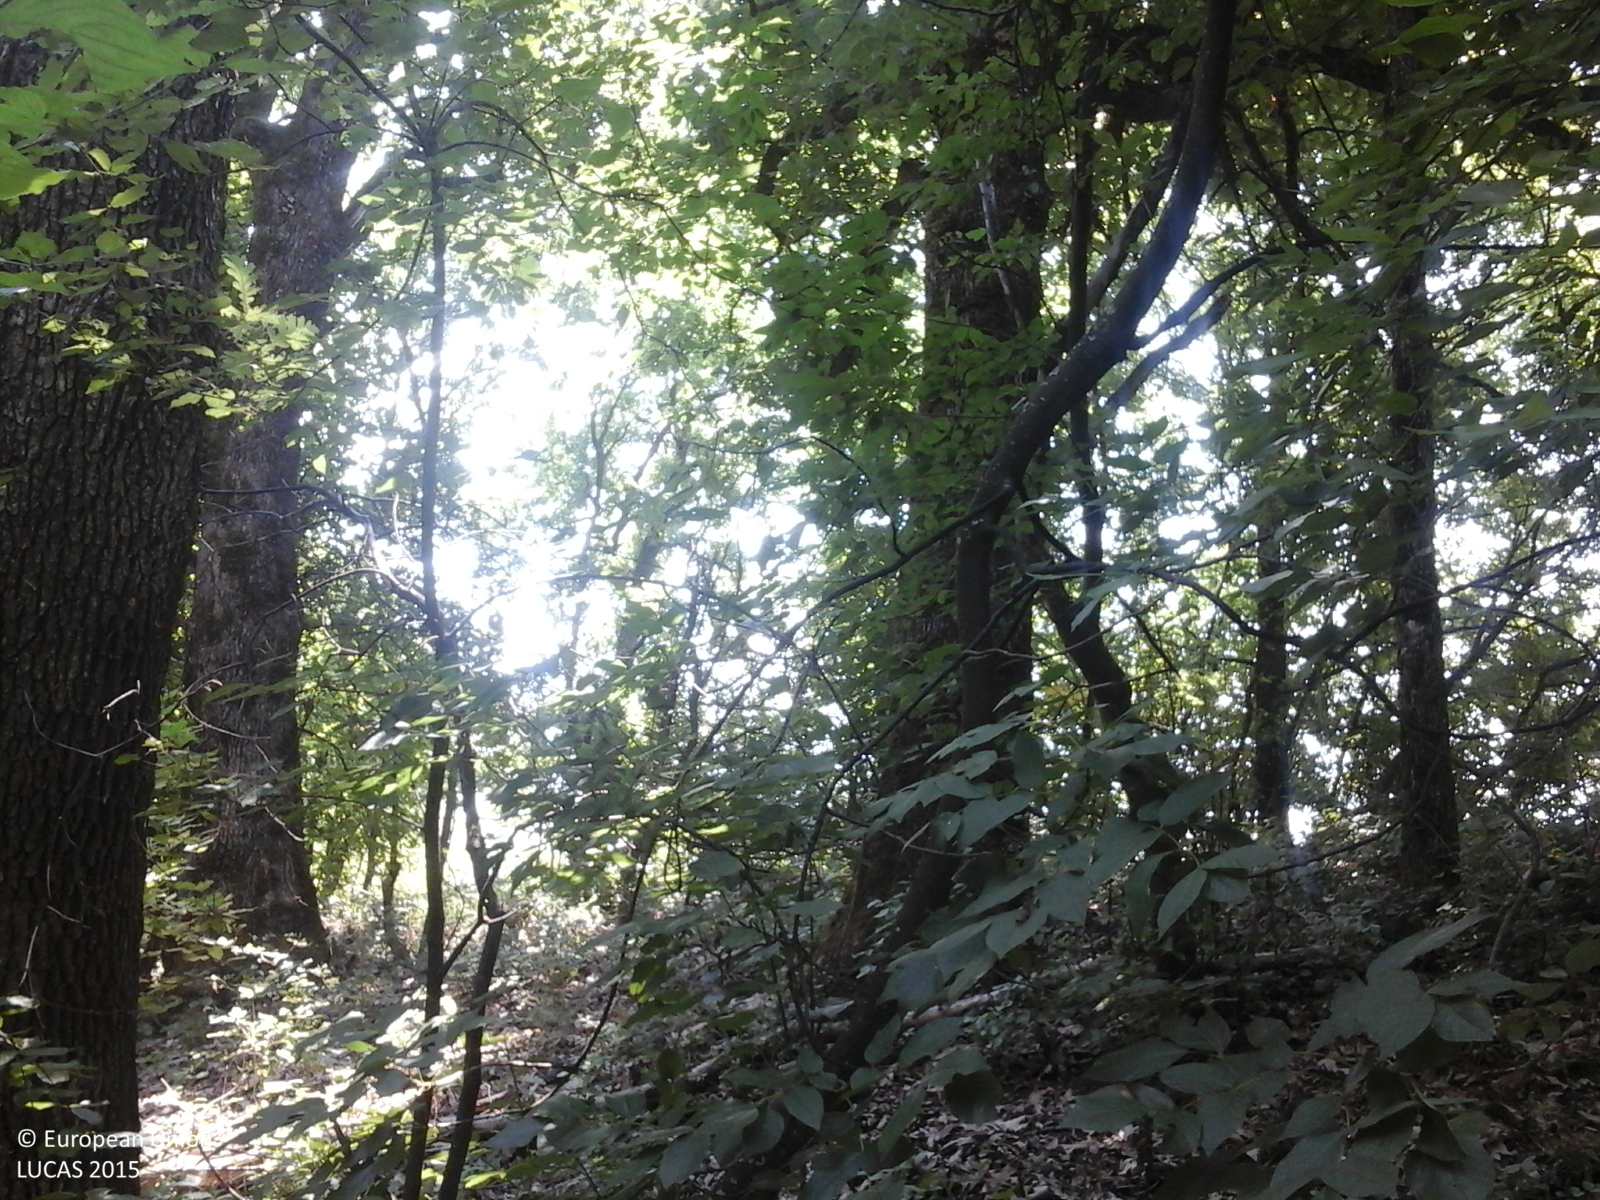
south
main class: Woodland
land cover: Broadleaved woodland
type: beech forest
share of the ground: > 75 %
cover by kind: broadleaved forest trees 100 %
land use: Forestry
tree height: > 5 m
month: July
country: RO
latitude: 44.7408
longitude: 24.4569
